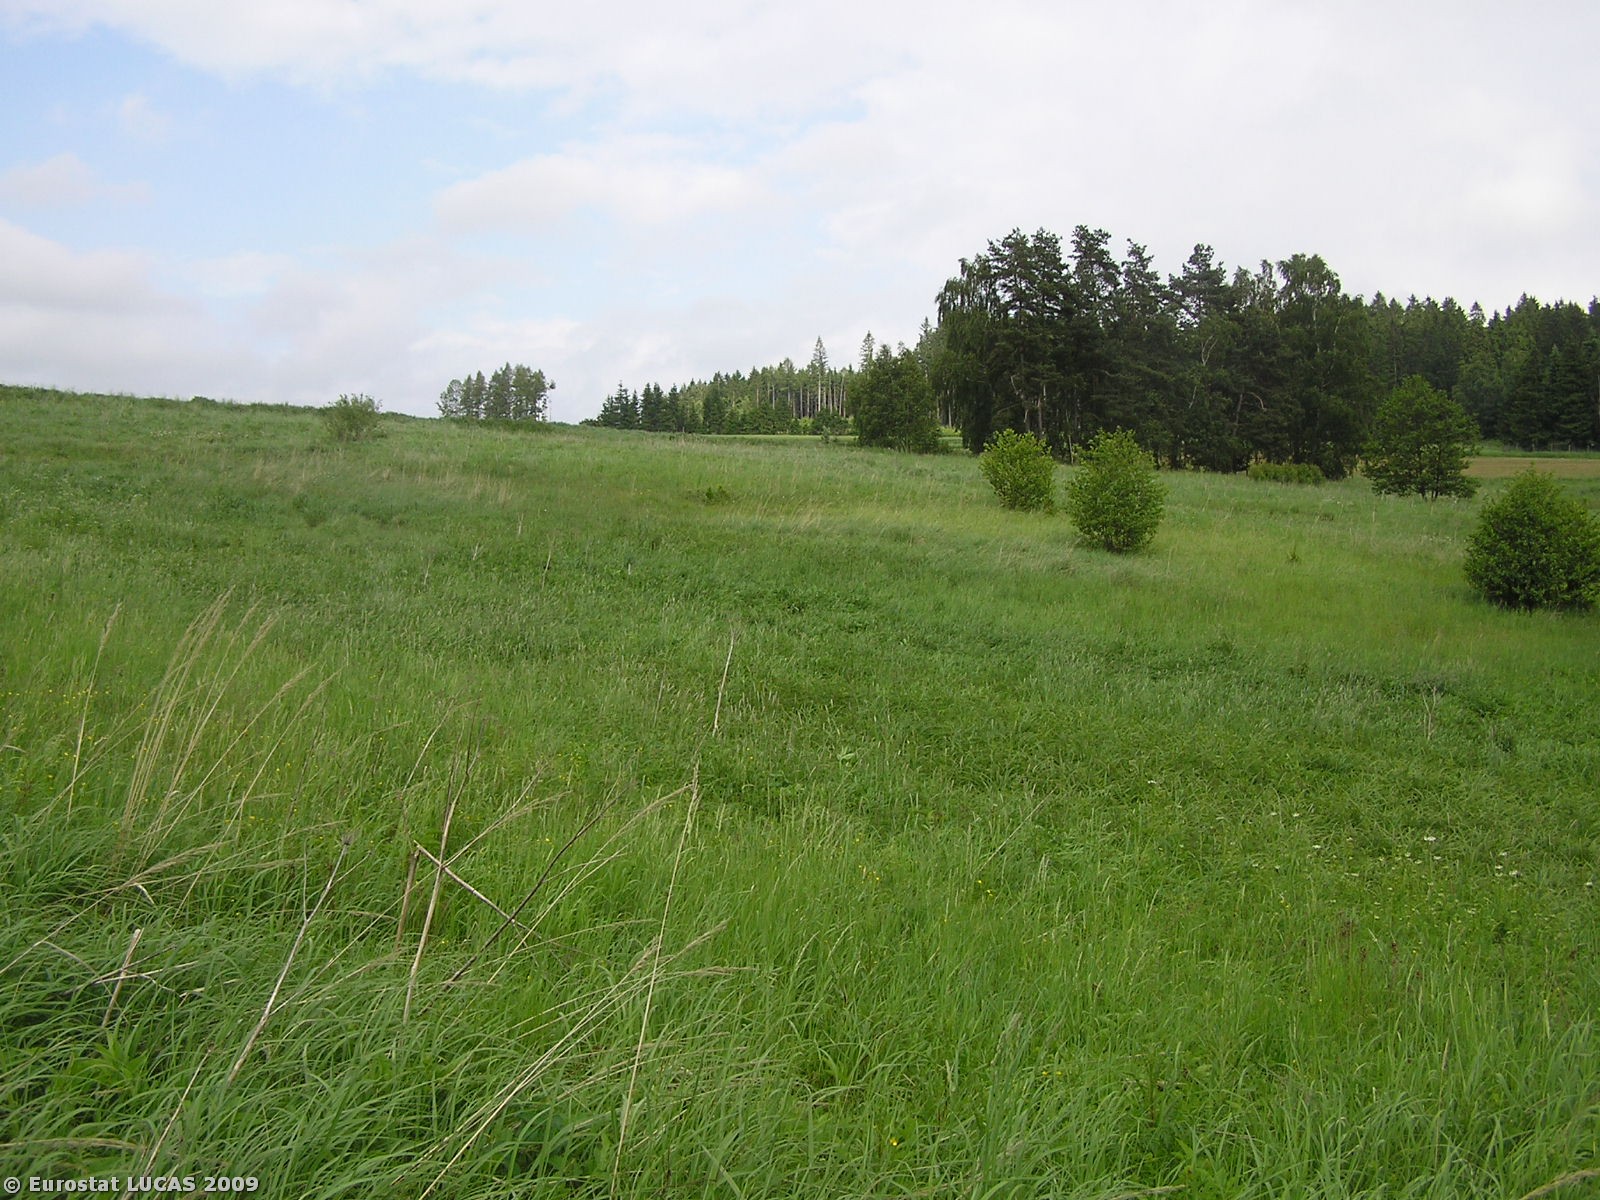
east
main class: Grassland
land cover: Grassland without tree/shrub cover
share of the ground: > 75 %
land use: Unused
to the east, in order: Grassland without tree/shrub cover; Tracks; Grassland with sparse tree/shrub cover; Maize
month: May
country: CZ
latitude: 49.3551
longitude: 14.9723
